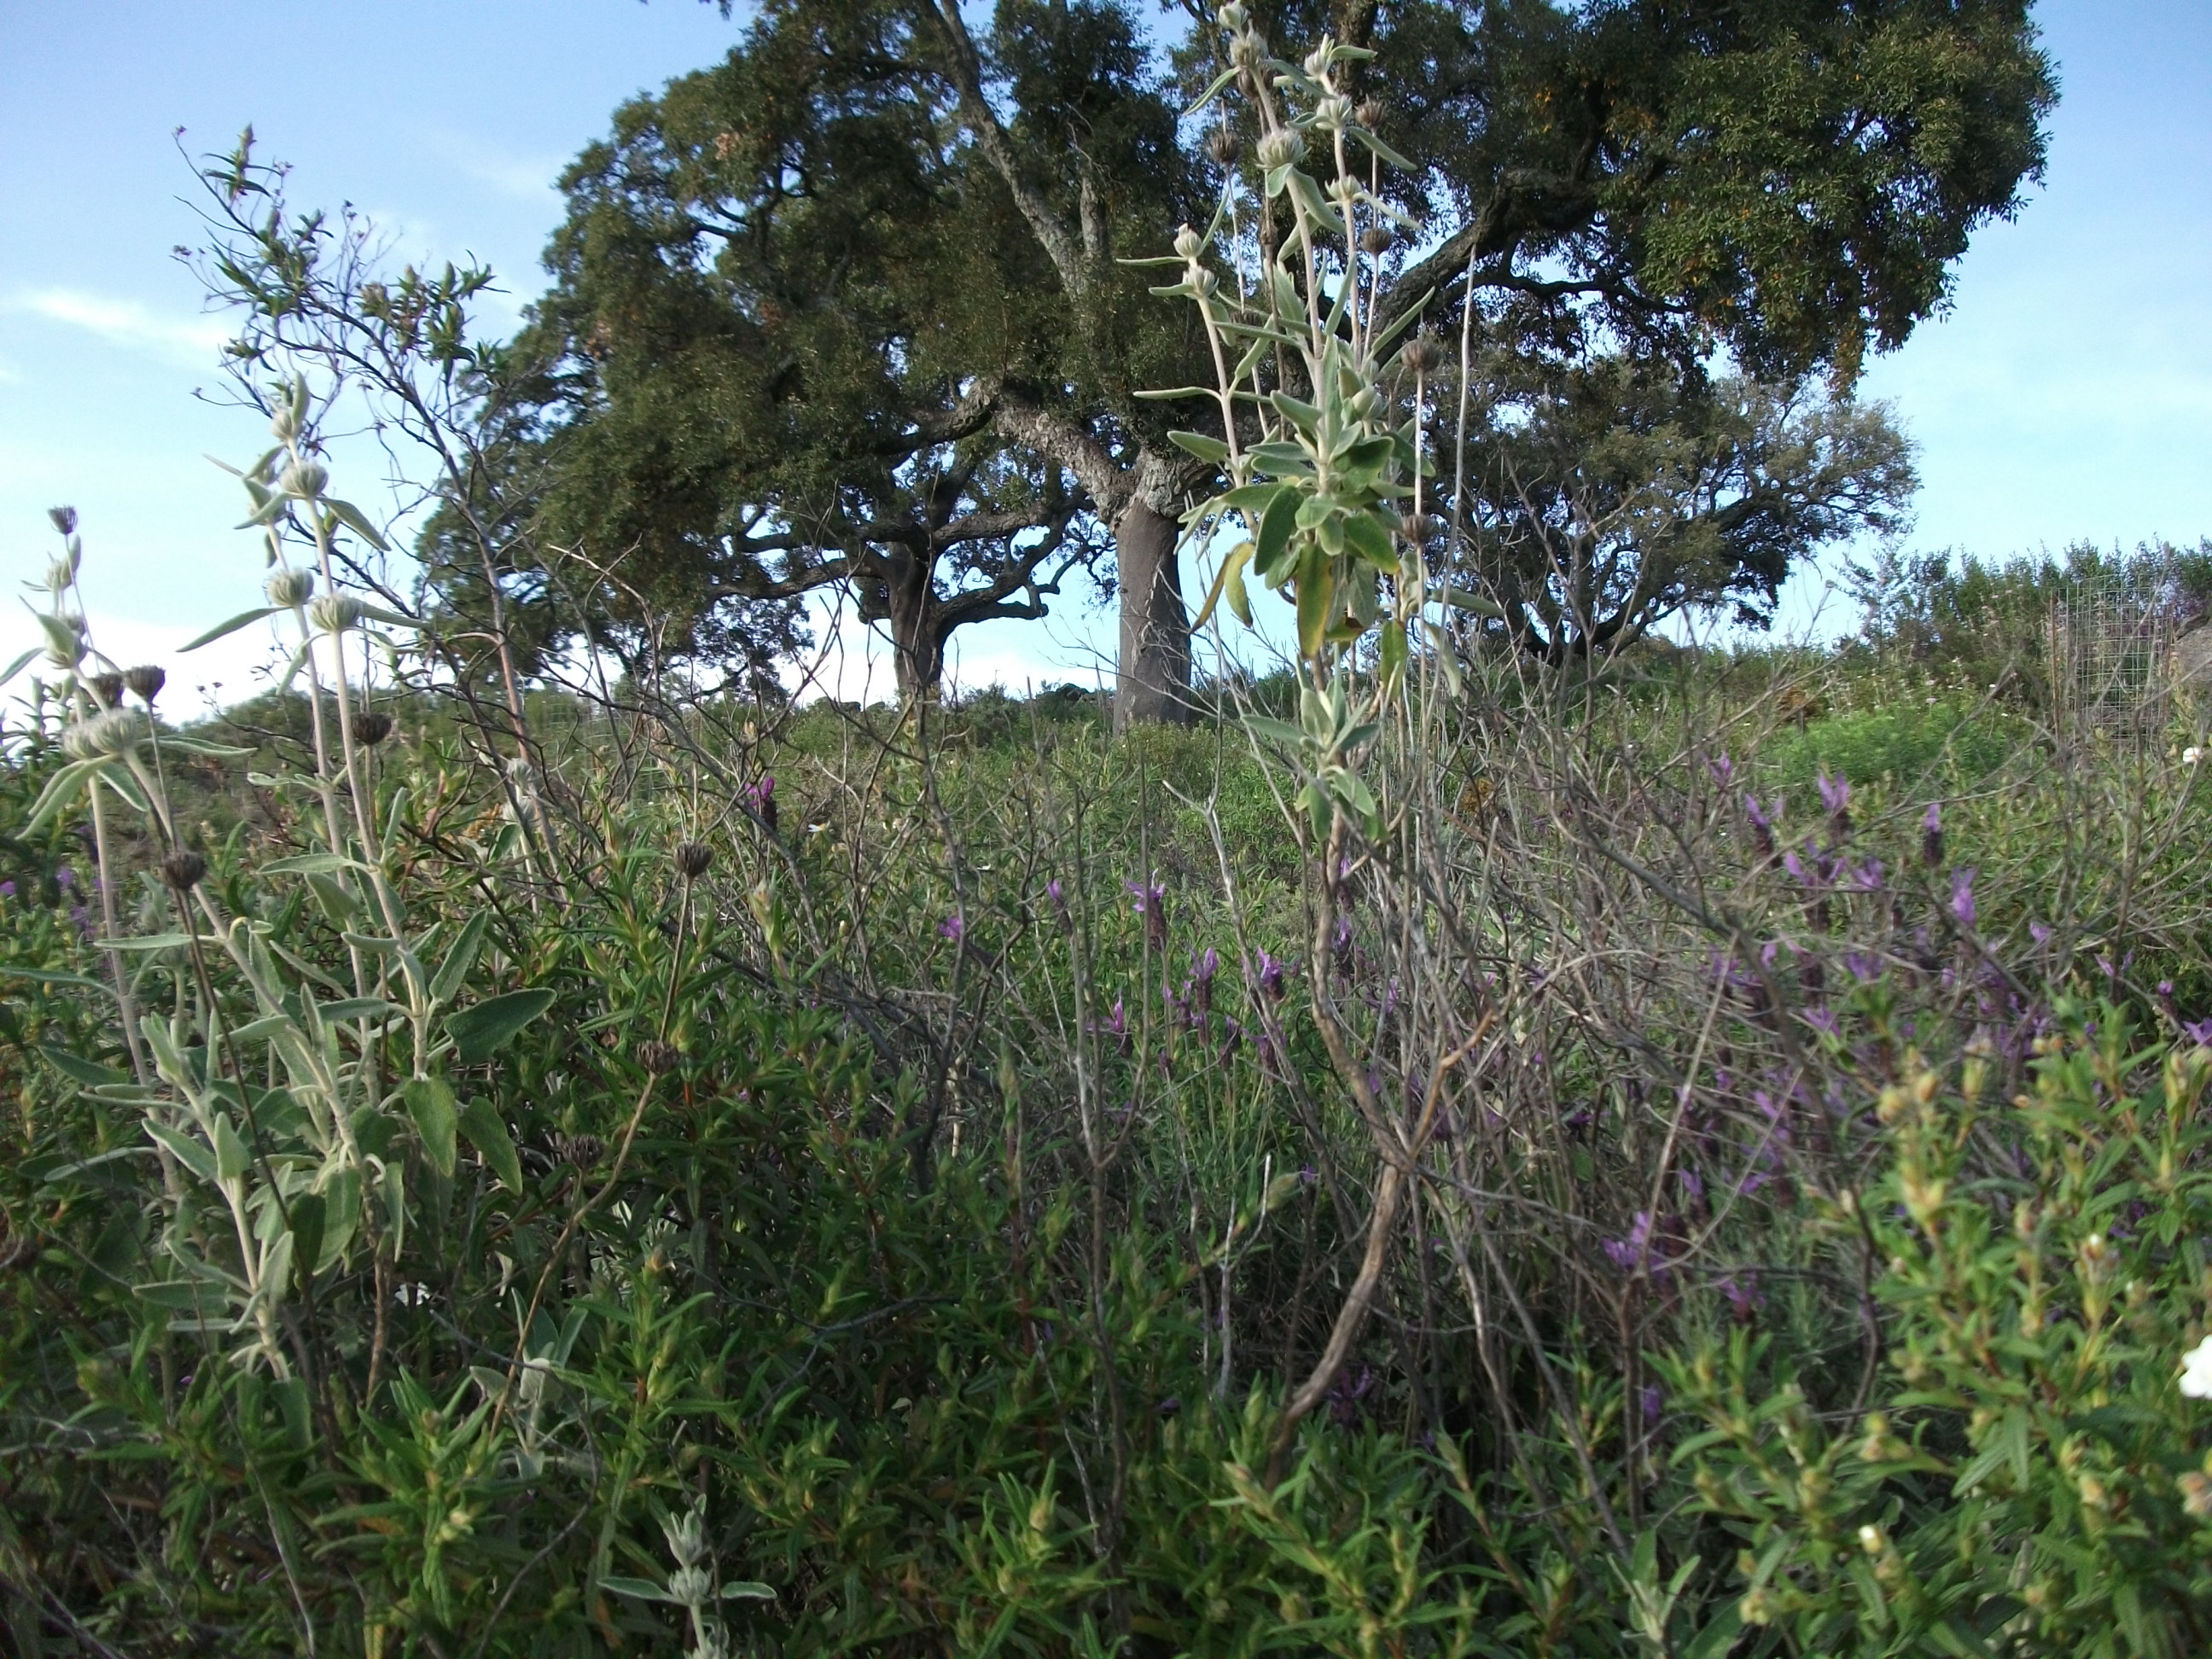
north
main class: Woodland
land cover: Broadleaved woodland
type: broadleaved evergreen forest
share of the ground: 10 - 25 %
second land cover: Shrubland without tree cover
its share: > 75 %
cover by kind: shrubs 90 %, broadleaved forest trees 10 %
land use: Forestry
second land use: Agriculture (excluding fallow land and kitchen gardens)
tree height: > 5 m
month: April
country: ES
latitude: 37.8756
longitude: -6.5386
